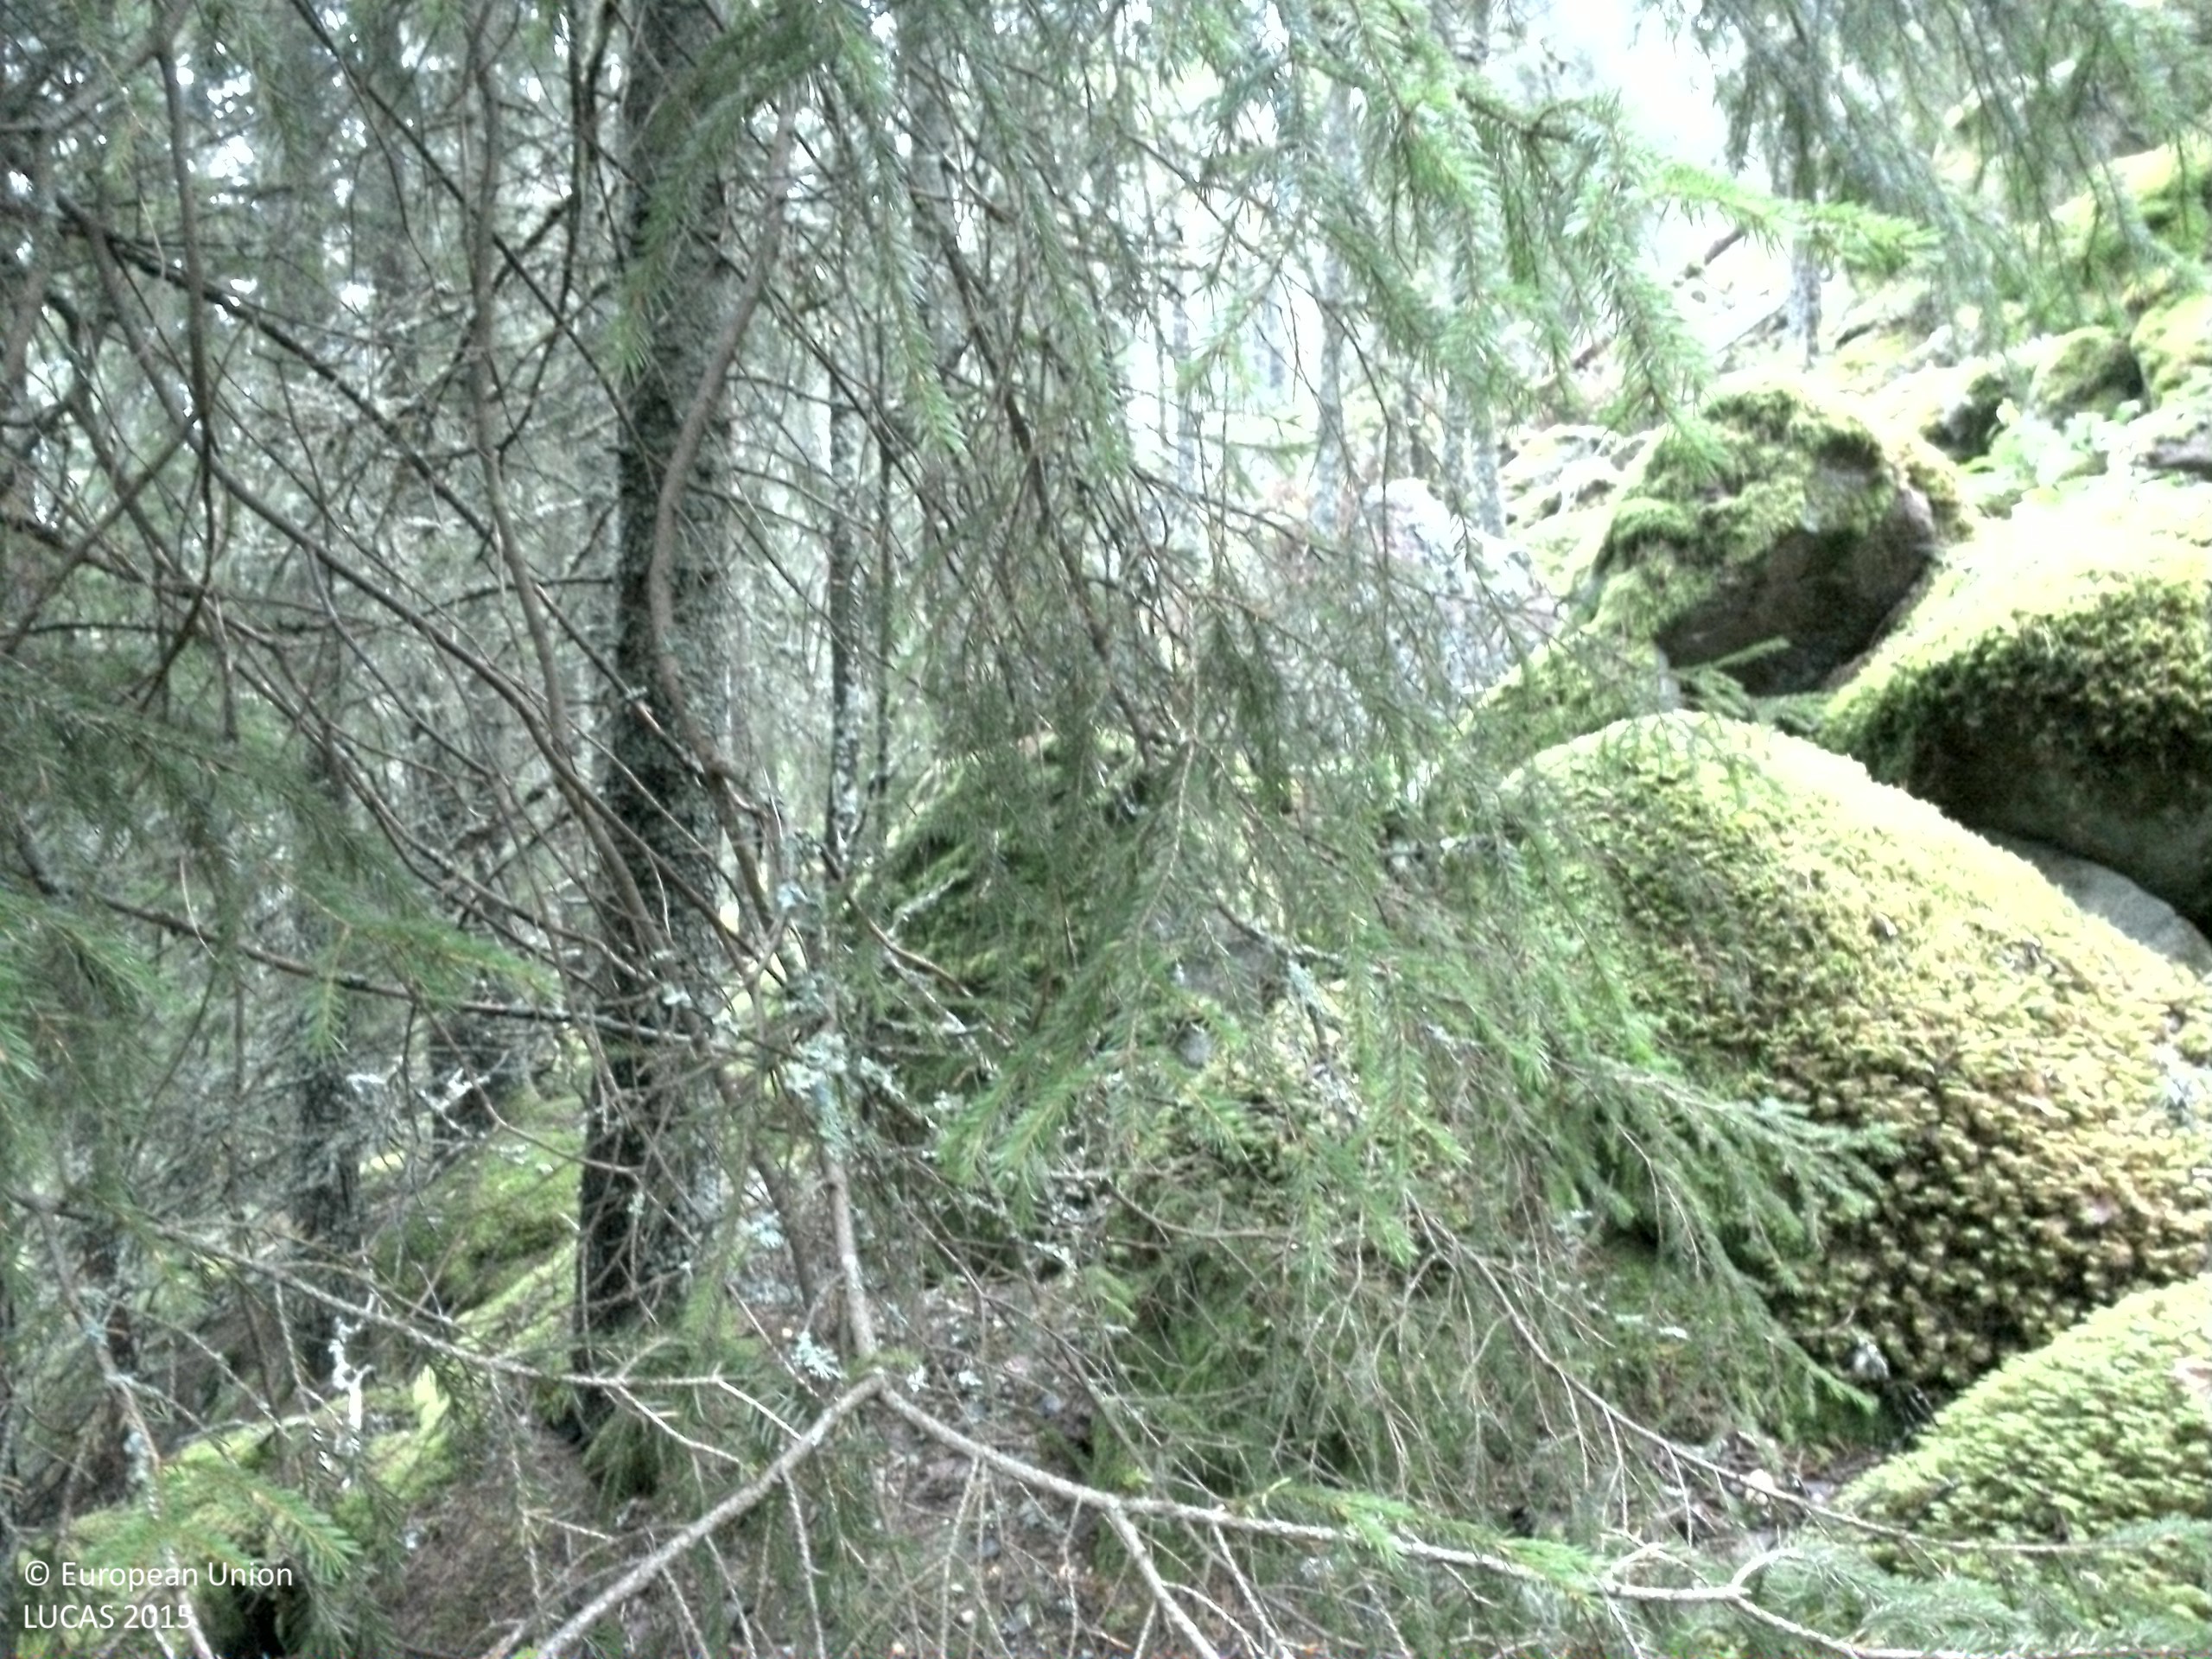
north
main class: Woodland
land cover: Spruce dominated coniferous woodland
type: boreal forest
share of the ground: 25 - 50 %
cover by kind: coniferous forest trees 45 %, lichens and mosses 30 %, shrubs 10 %, herbaceous plants 10 %, broadleaved forest trees 5 %
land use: Amenities, museums, leisure
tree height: > 5 m
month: September
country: SE
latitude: 59.8376
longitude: 13.2212
